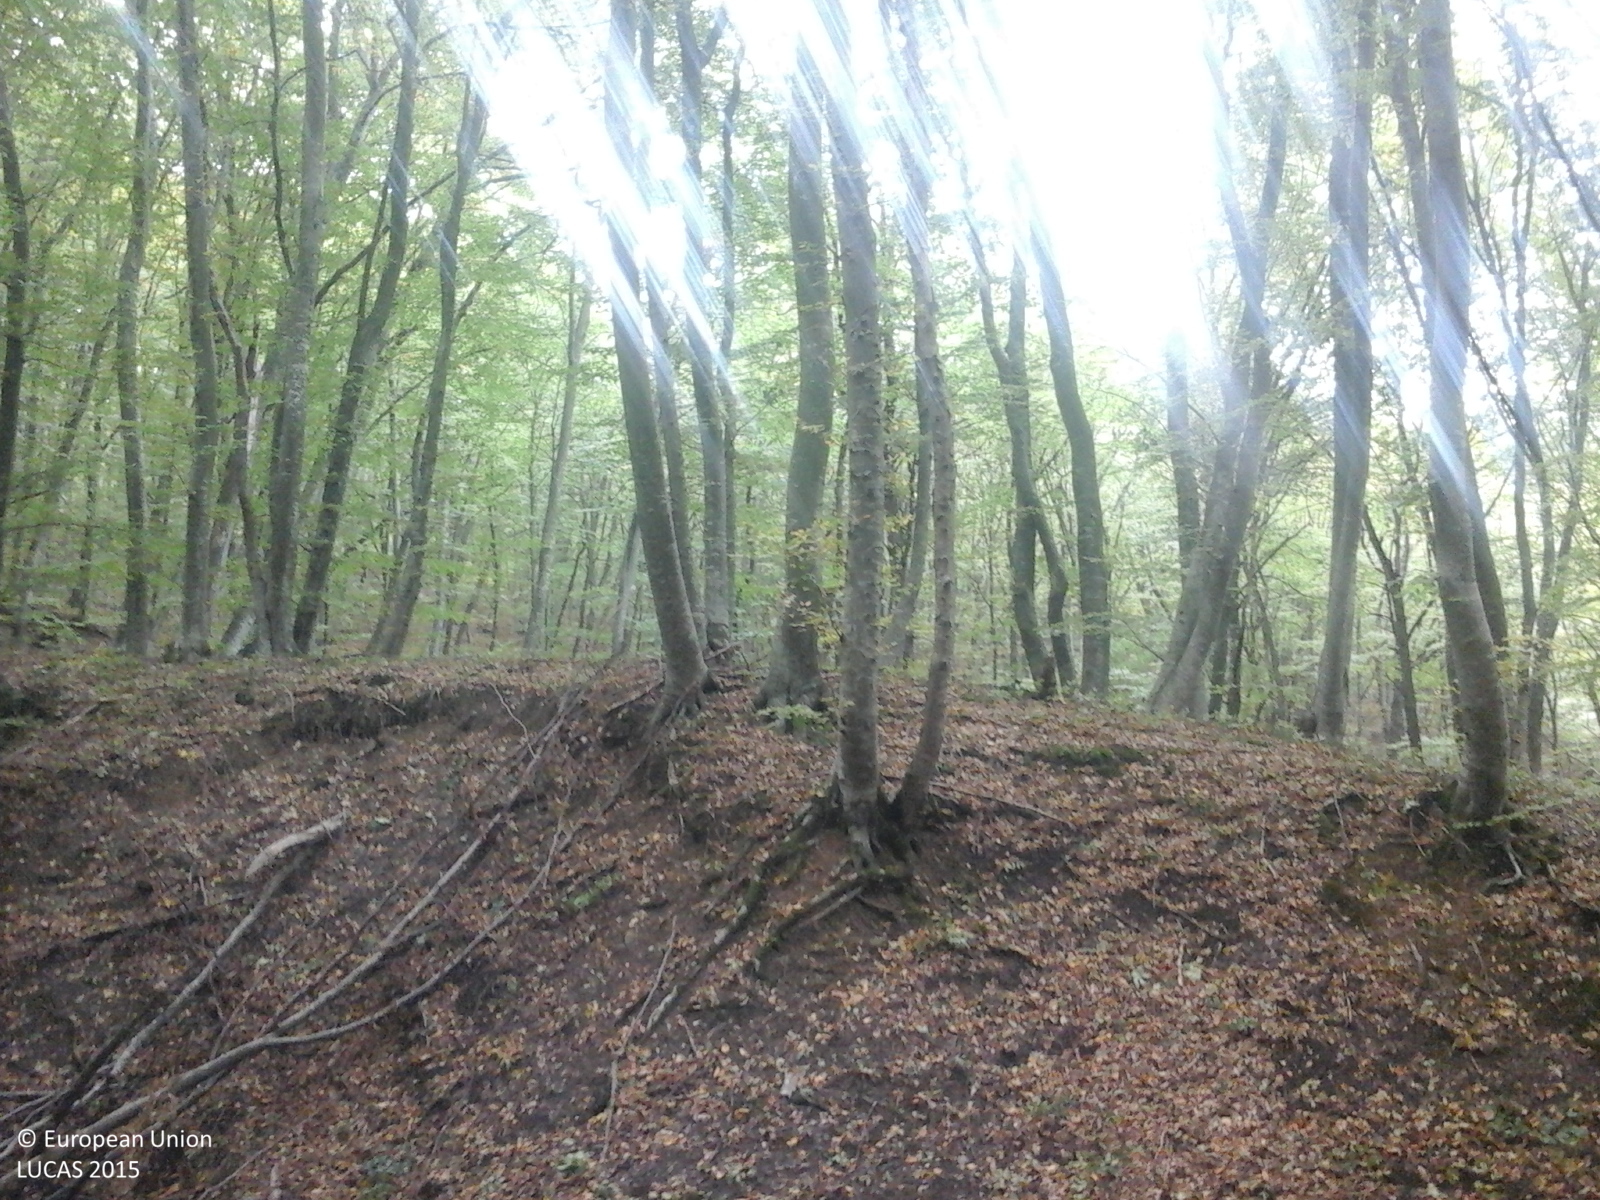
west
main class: Woodland
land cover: Broadleaved woodland
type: beech forest
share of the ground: > 75 %
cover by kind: broadleaved forest trees 100 %
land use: Forestry
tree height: > 5 m
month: October
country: RO
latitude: 46.2664
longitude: 25.0570
